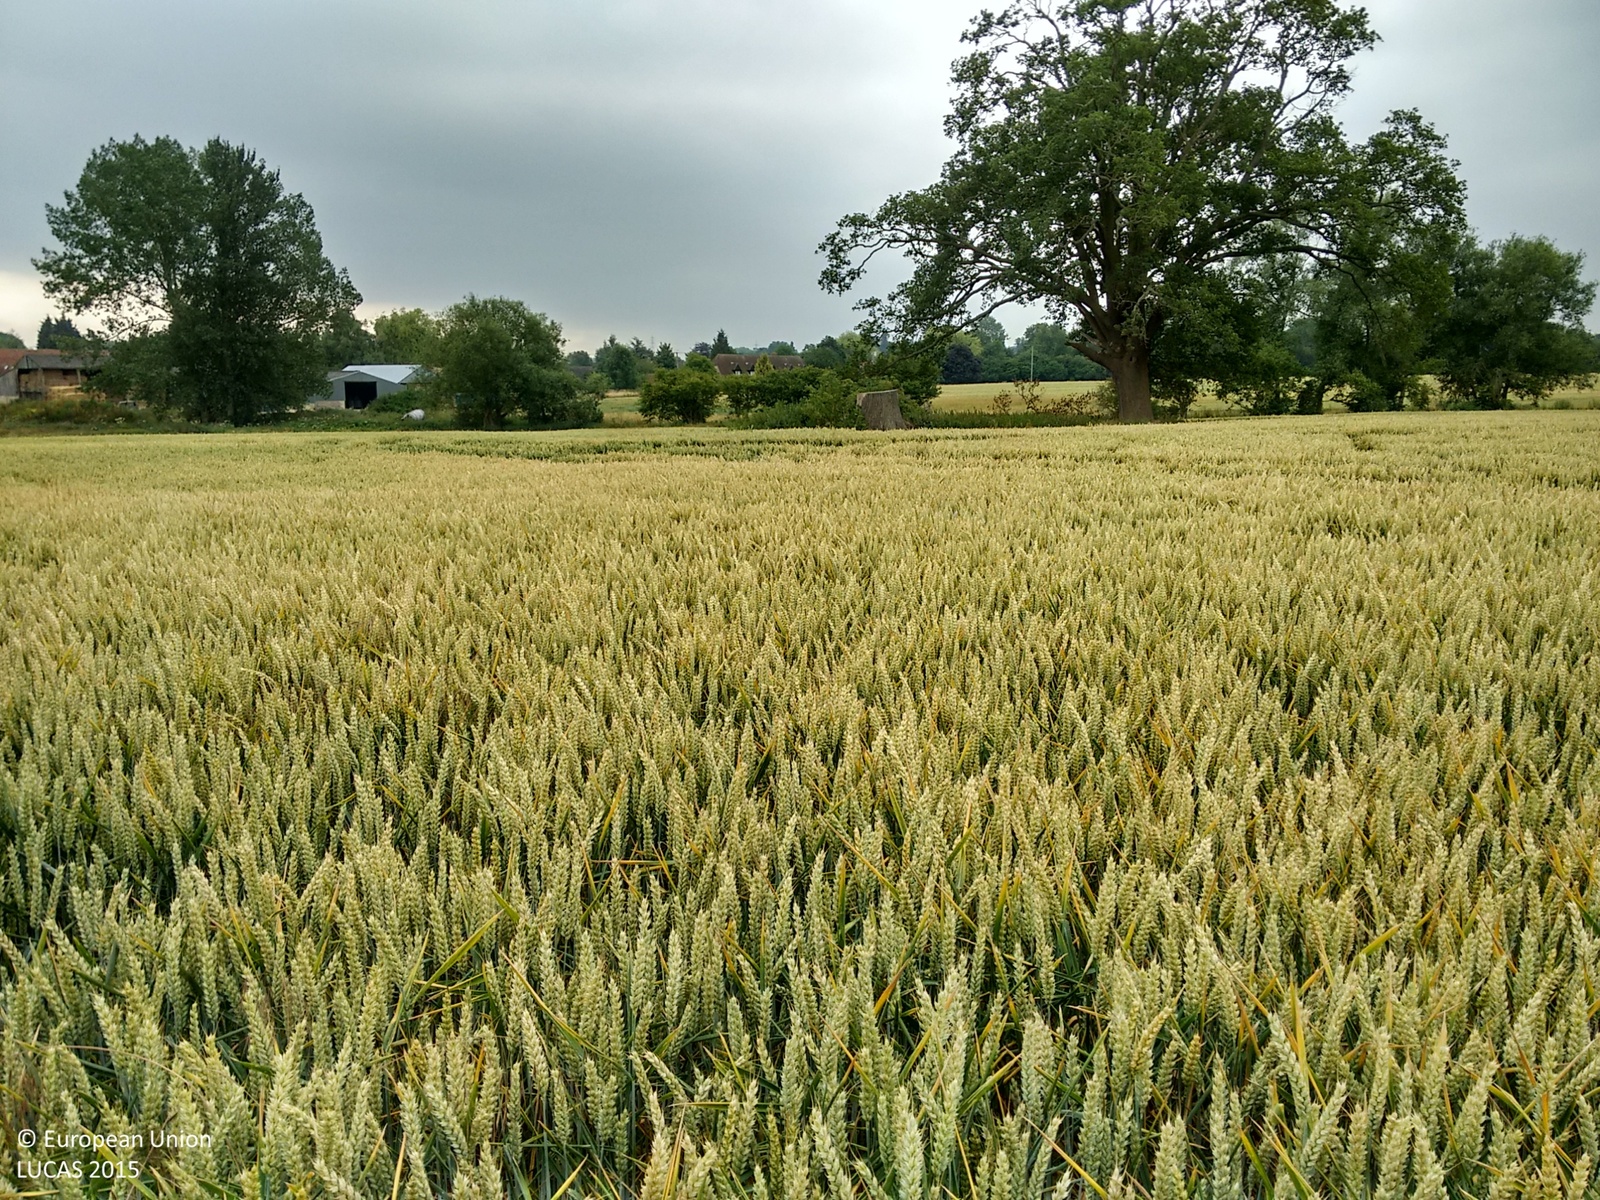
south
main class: Cropland
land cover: Common wheat
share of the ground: > 75 %
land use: Agriculture (excluding fallow land and kitchen gardens)
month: July
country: GB
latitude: 51.7615
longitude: -1.1301
